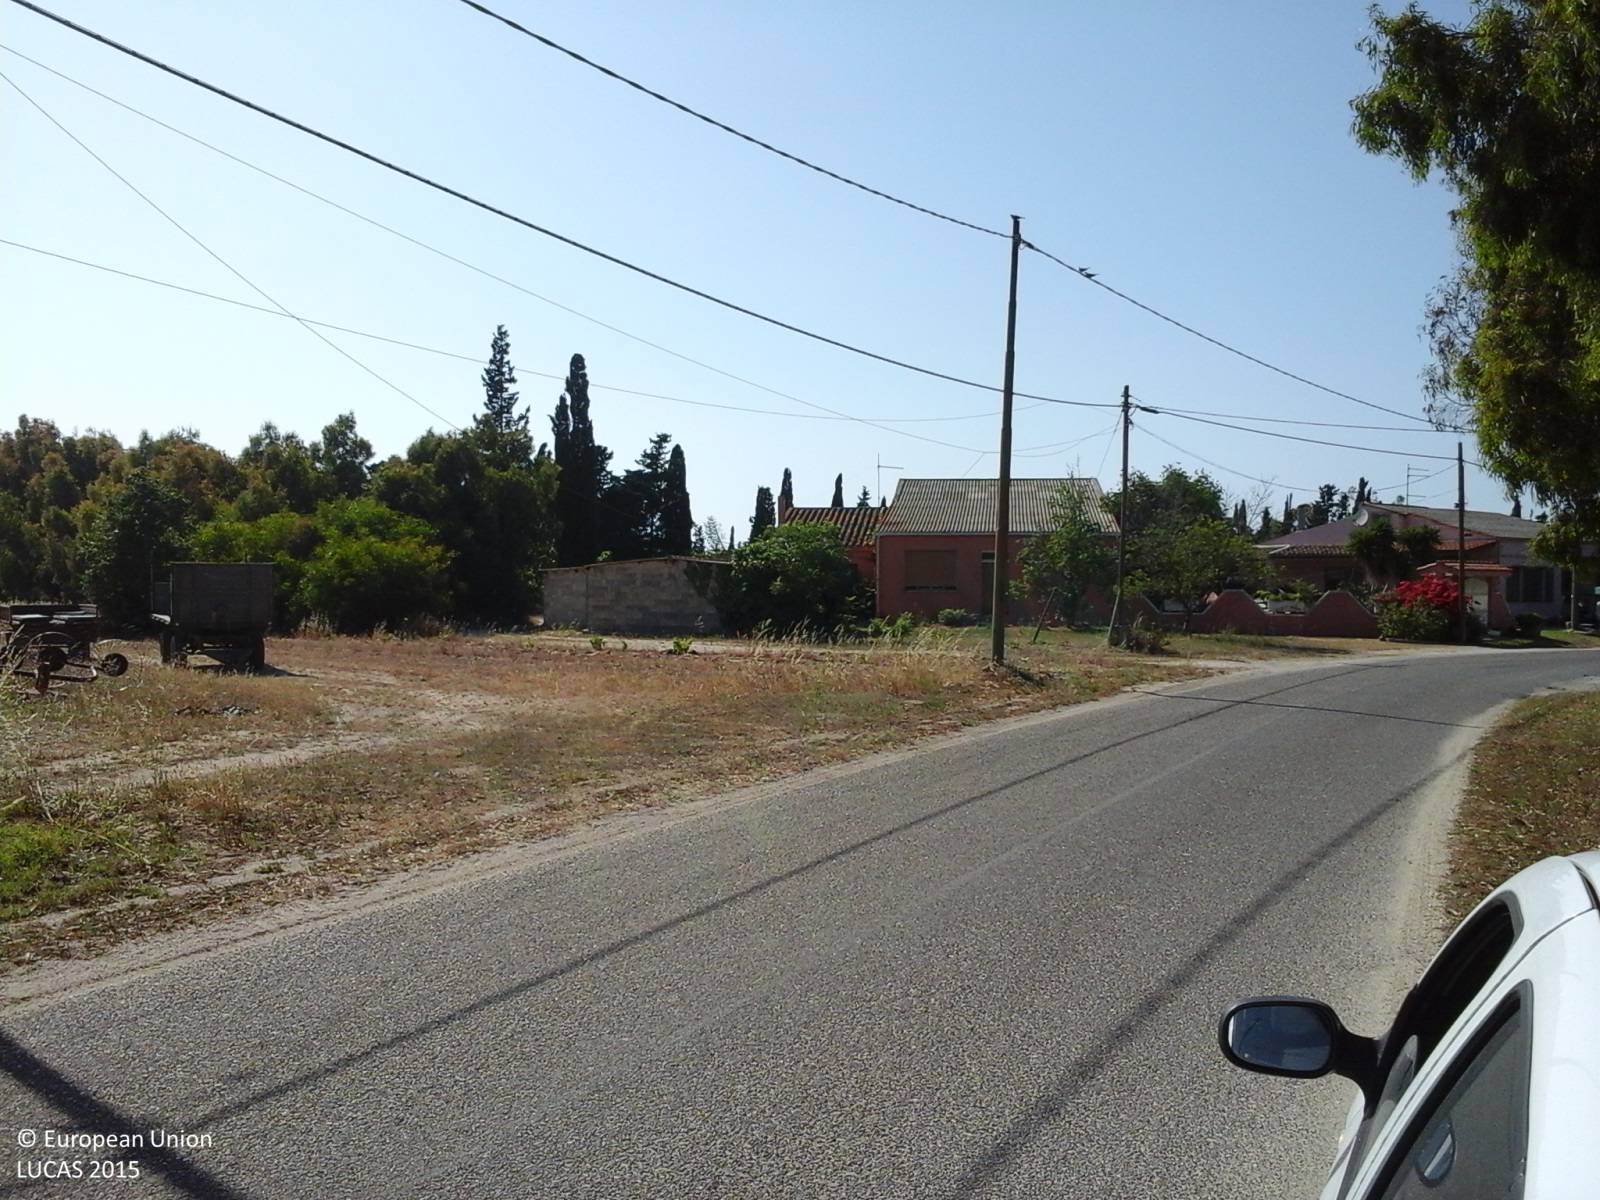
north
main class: Woodland
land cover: Broadleaved woodland
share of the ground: > 75 %
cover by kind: broadleaved forest trees 80 %, herbaceous plants 20 %
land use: Forestry
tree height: > 5 m
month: May
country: IT
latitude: 39.8408
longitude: 8.5938
